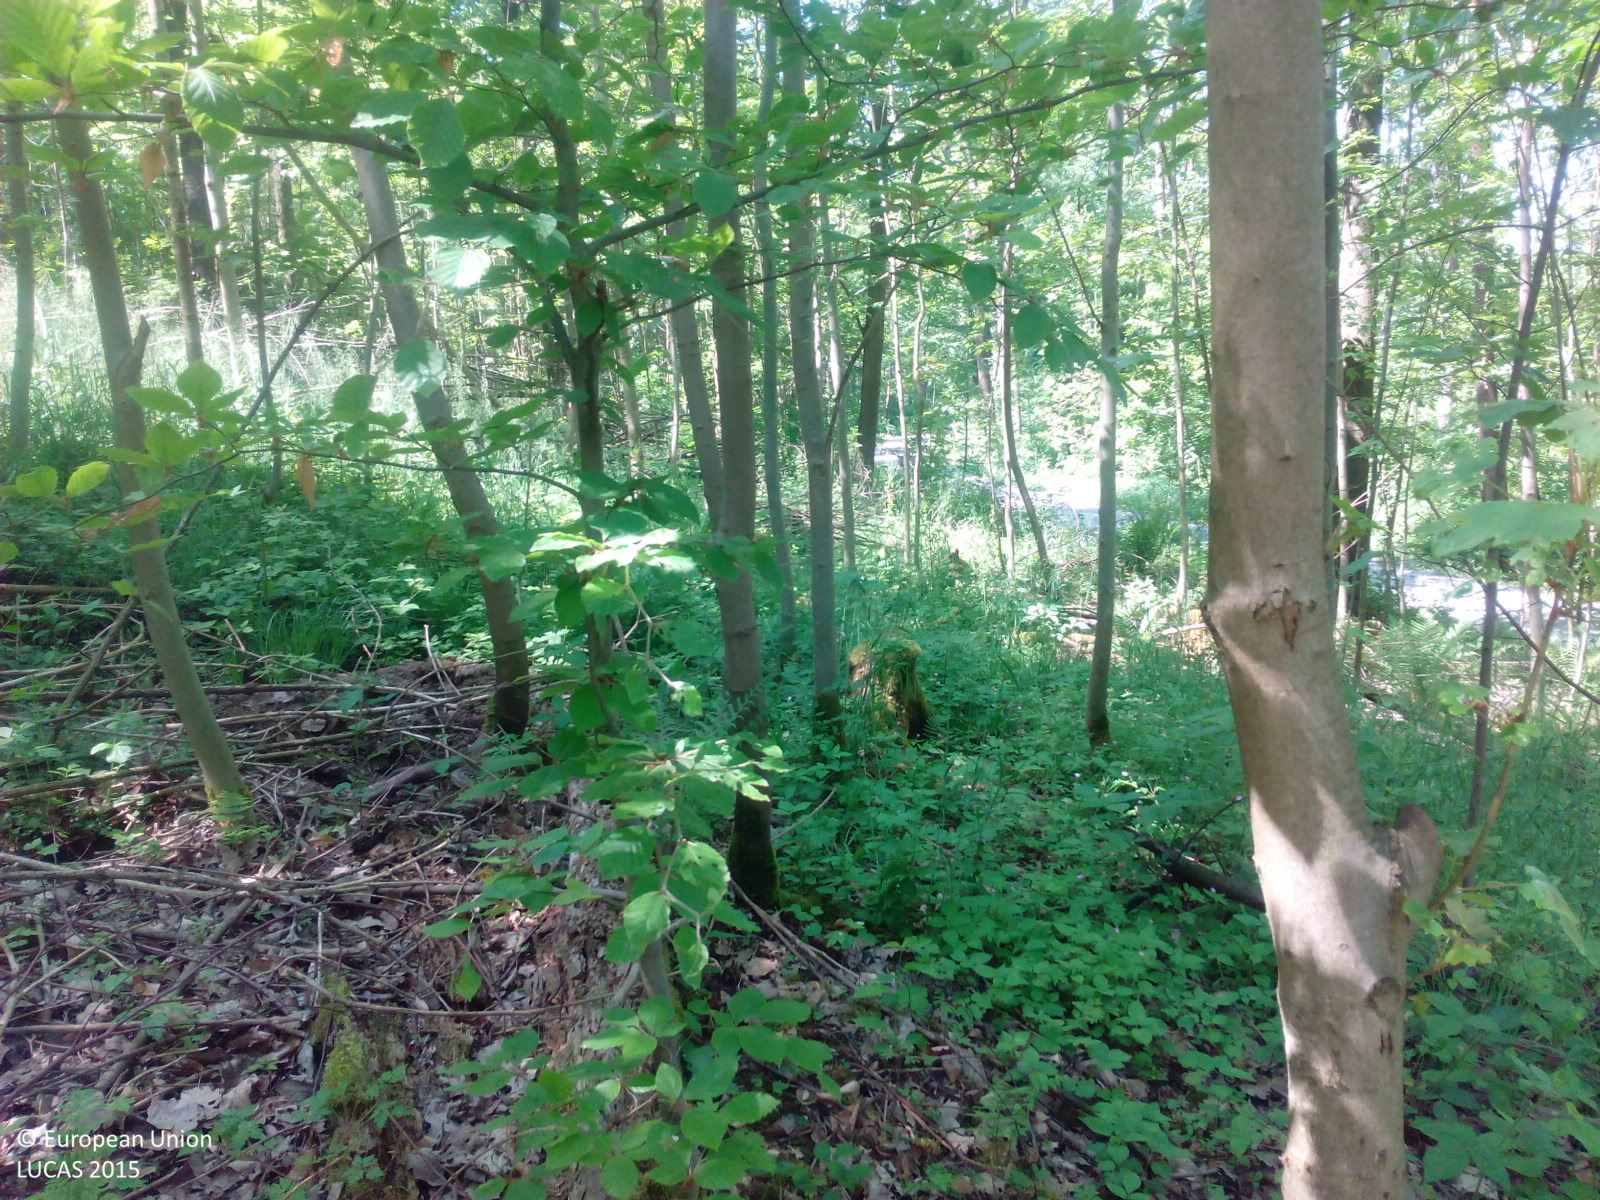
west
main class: Woodland
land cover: Broadleaved woodland
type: mesophytic deciduous forest
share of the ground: > 75 %
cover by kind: broadleaved forest trees 75 %, herbaceous plants 20 %, shrubs 5 %
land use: Forestry
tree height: > 5 m
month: May
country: DE
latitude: 49.0308
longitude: 9.2754
